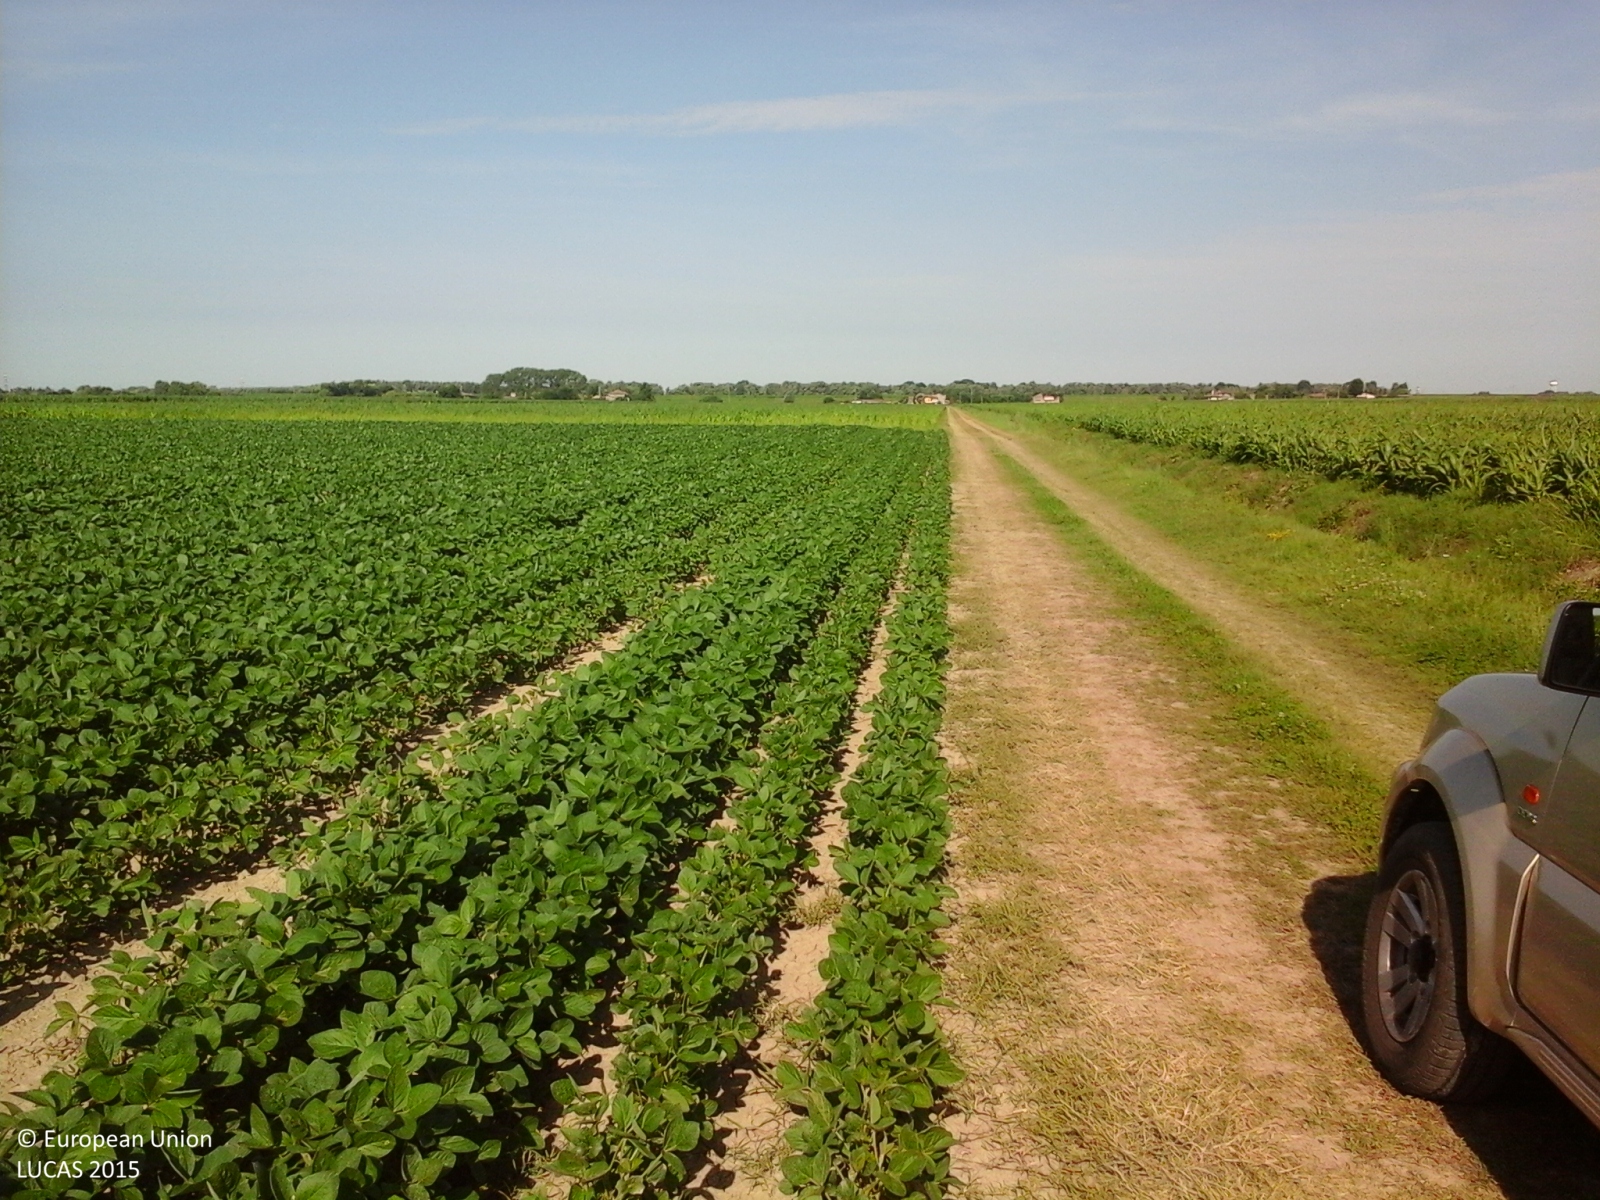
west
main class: Cropland
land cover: Soya
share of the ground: > 75 %
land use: Agriculture (excluding fallow land and kitchen gardens)
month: June
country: IT
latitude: 44.9933
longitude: 12.2664
